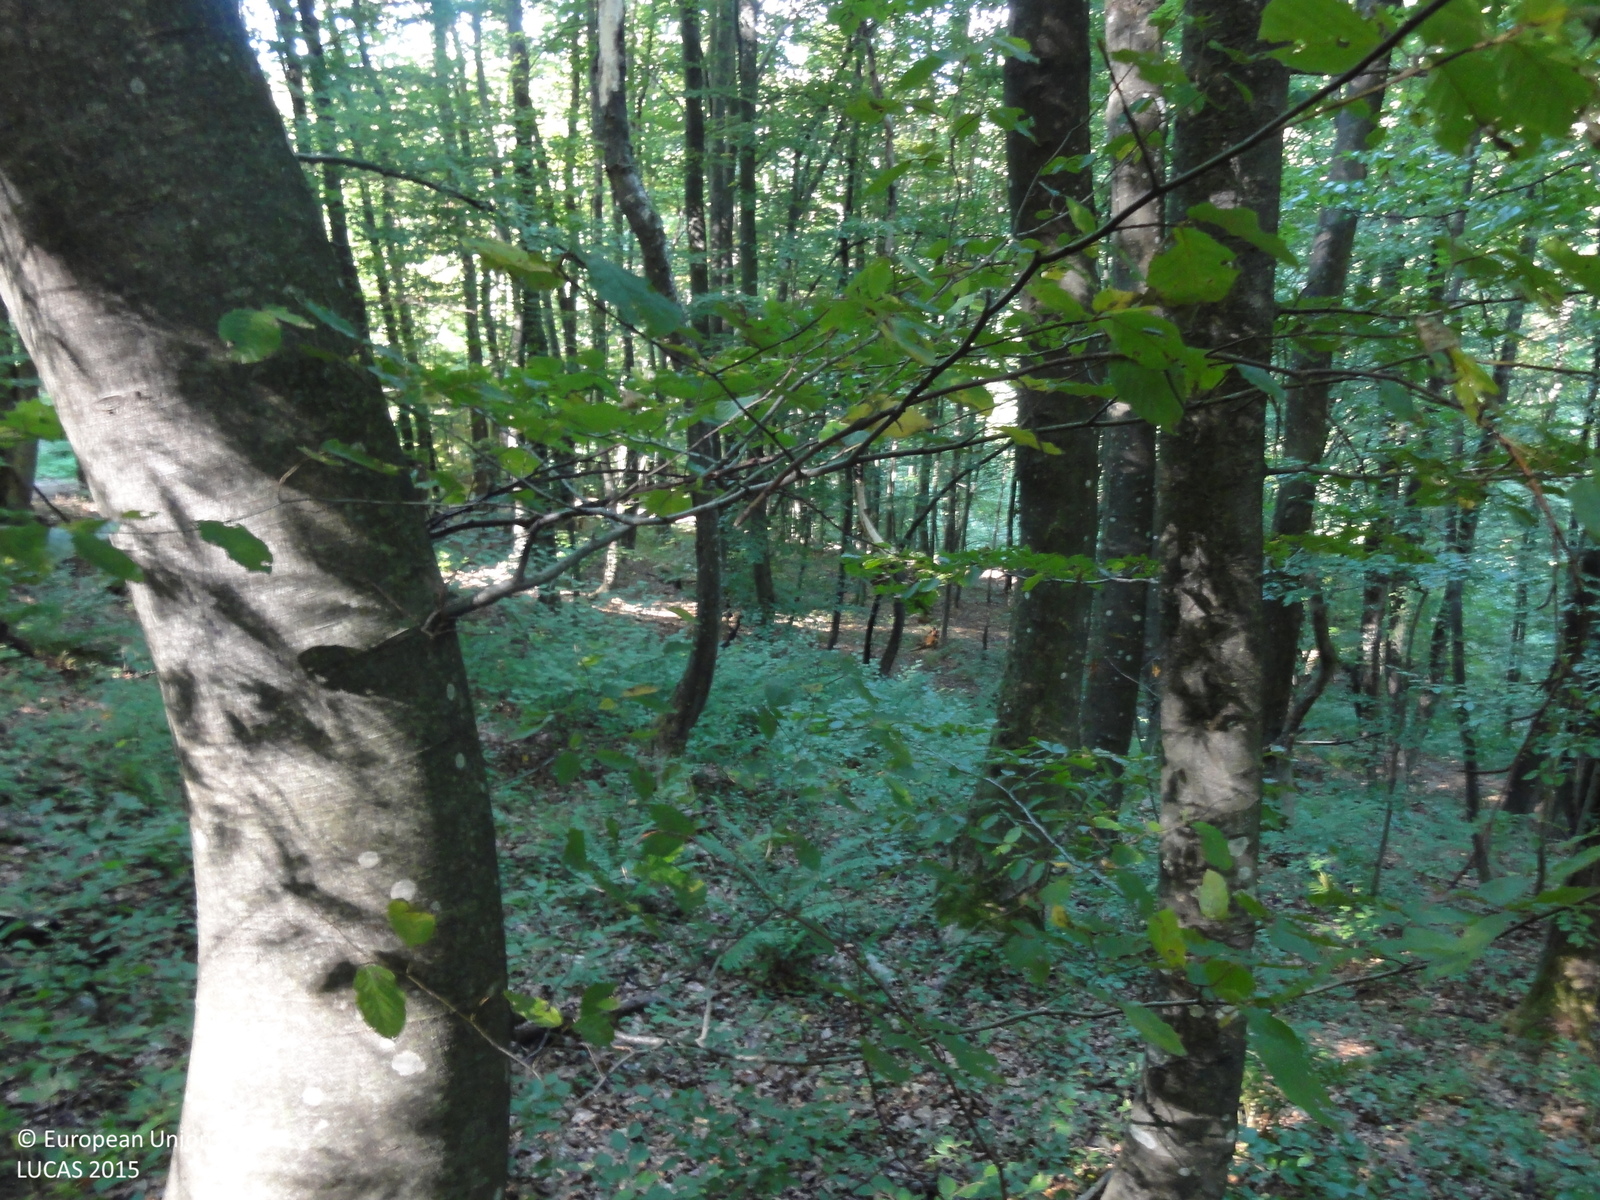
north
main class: Woodland
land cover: Broadleaved woodland
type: beech forest
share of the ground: > 75 %
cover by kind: broadleaved forest trees 100 %
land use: Forestry
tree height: > 5 m
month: September
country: SI
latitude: 45.8143
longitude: 15.4665
